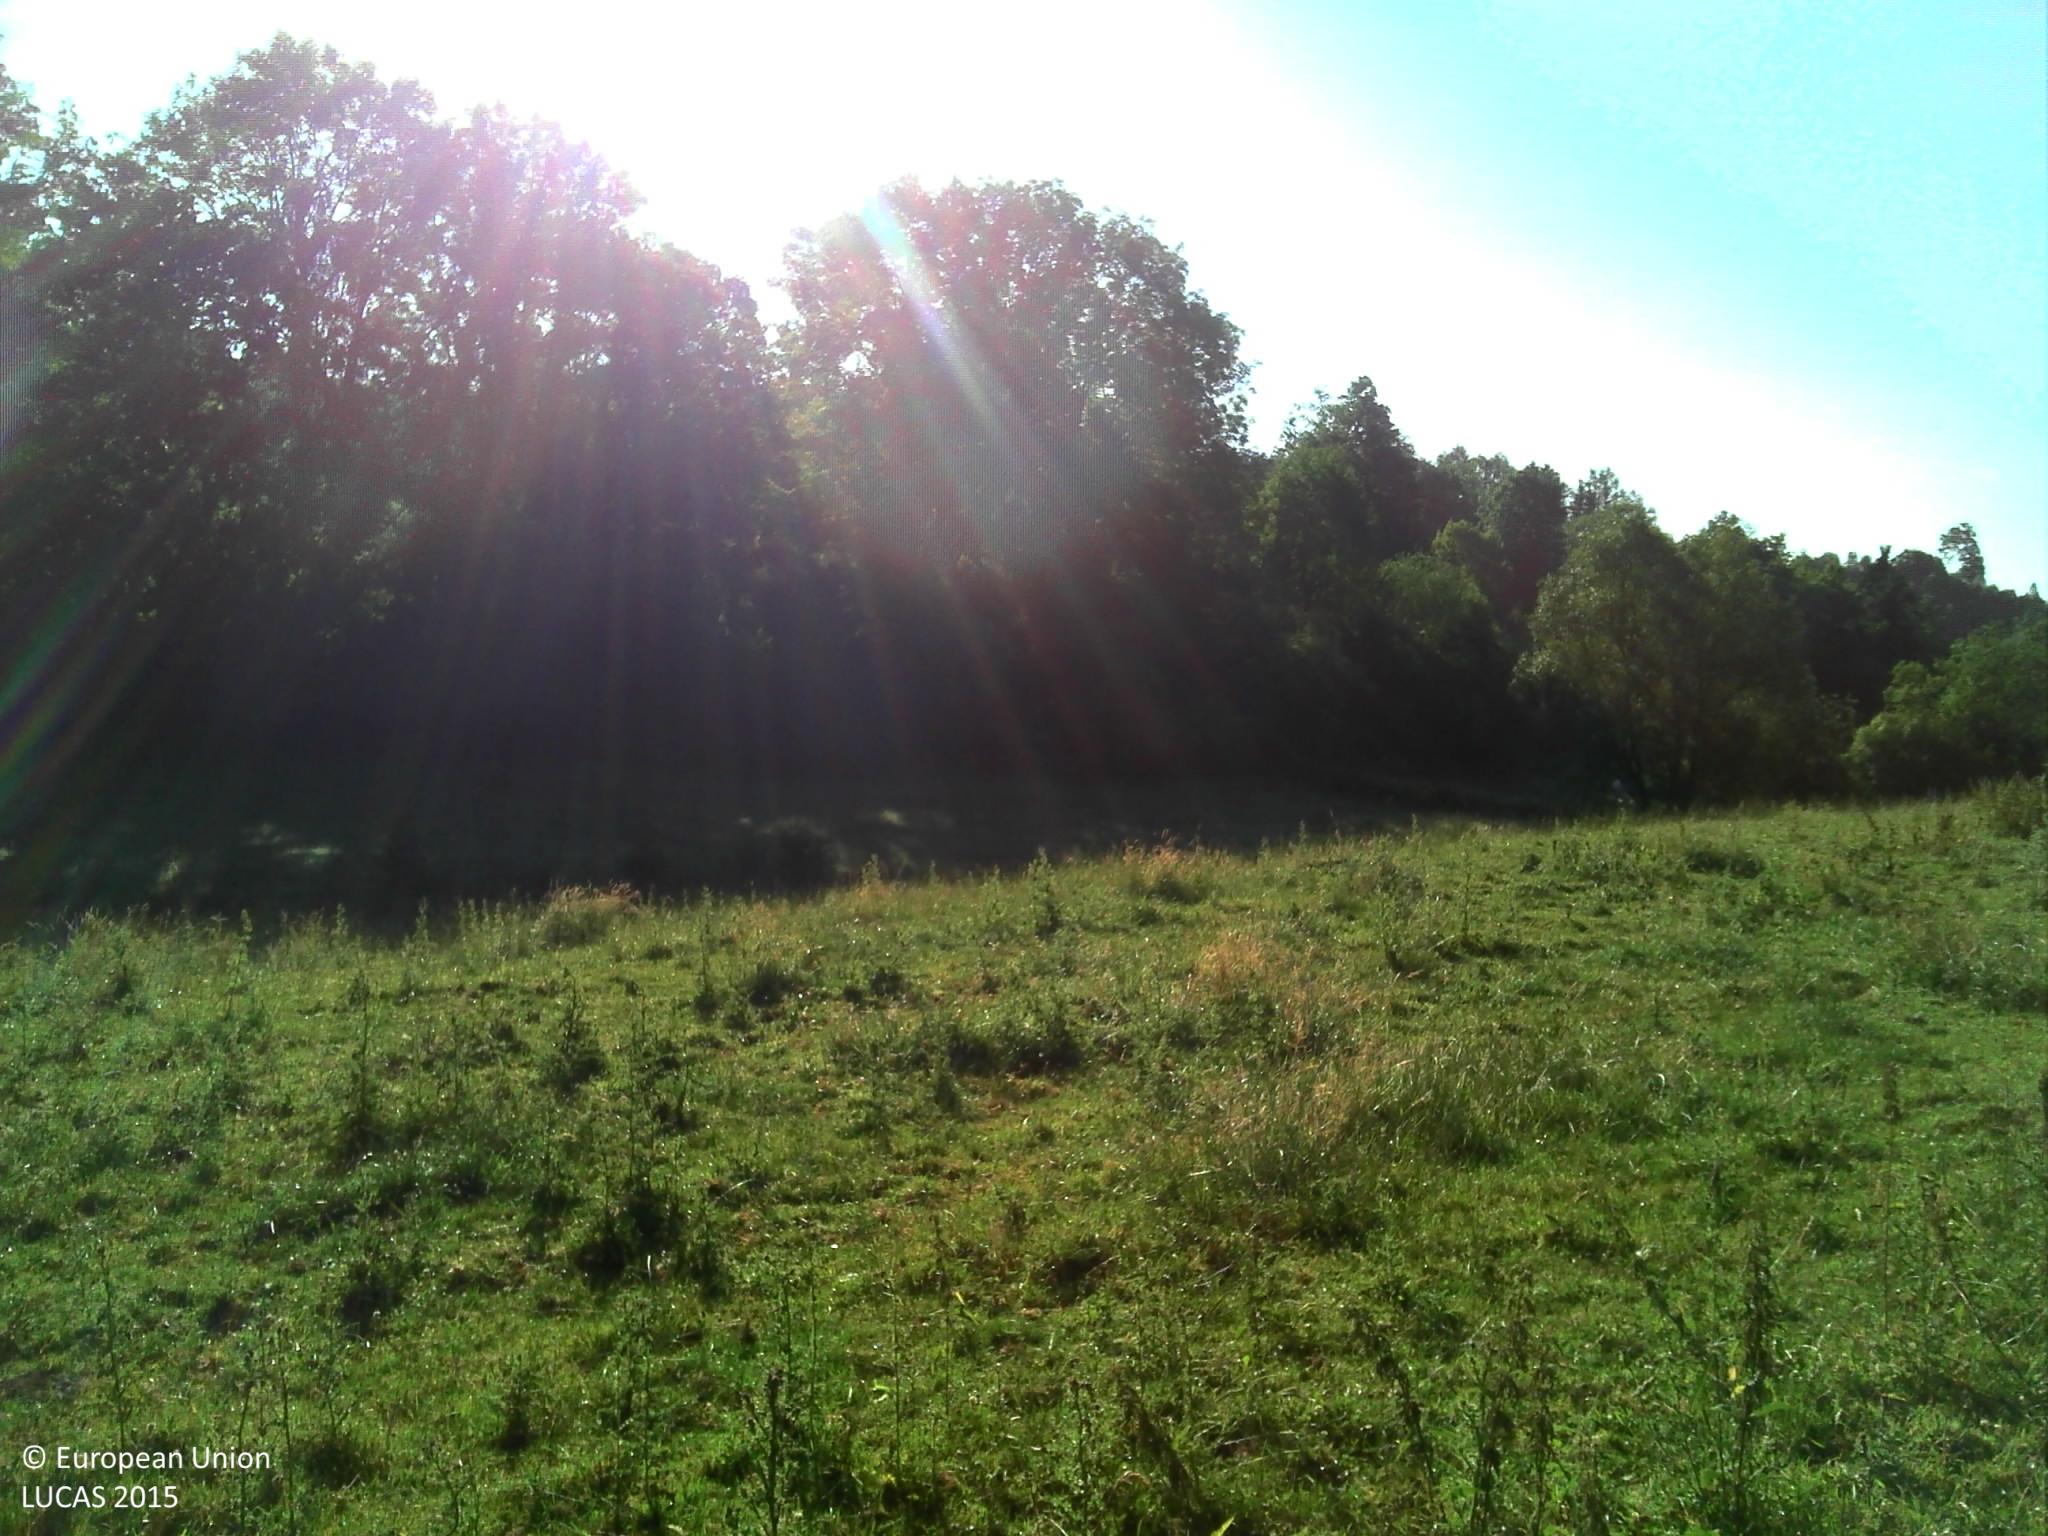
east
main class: Grassland
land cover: Grassland without tree/shrub cover
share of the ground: > 75 %
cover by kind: herbaceous plants 100 %
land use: Agriculture (excluding fallow land and kitchen gardens)
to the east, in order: Grassland without tree/shrub cover; Fences; Rivers and streams; Fences; Grassland without tree/shrub cover; Fences; Broadleaved woodland; Grass margins; Paved roads, cycling and walking lanes; Grass margins; Broadleaved woodland; Spontaneously vegetated surfaces; Grassland without tree/shrub cover; Broadleaved woodland; Shrubland without tree cover; Spruce dominated coniferous woodland
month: July
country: BE
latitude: 50.1182
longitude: 5.6210
